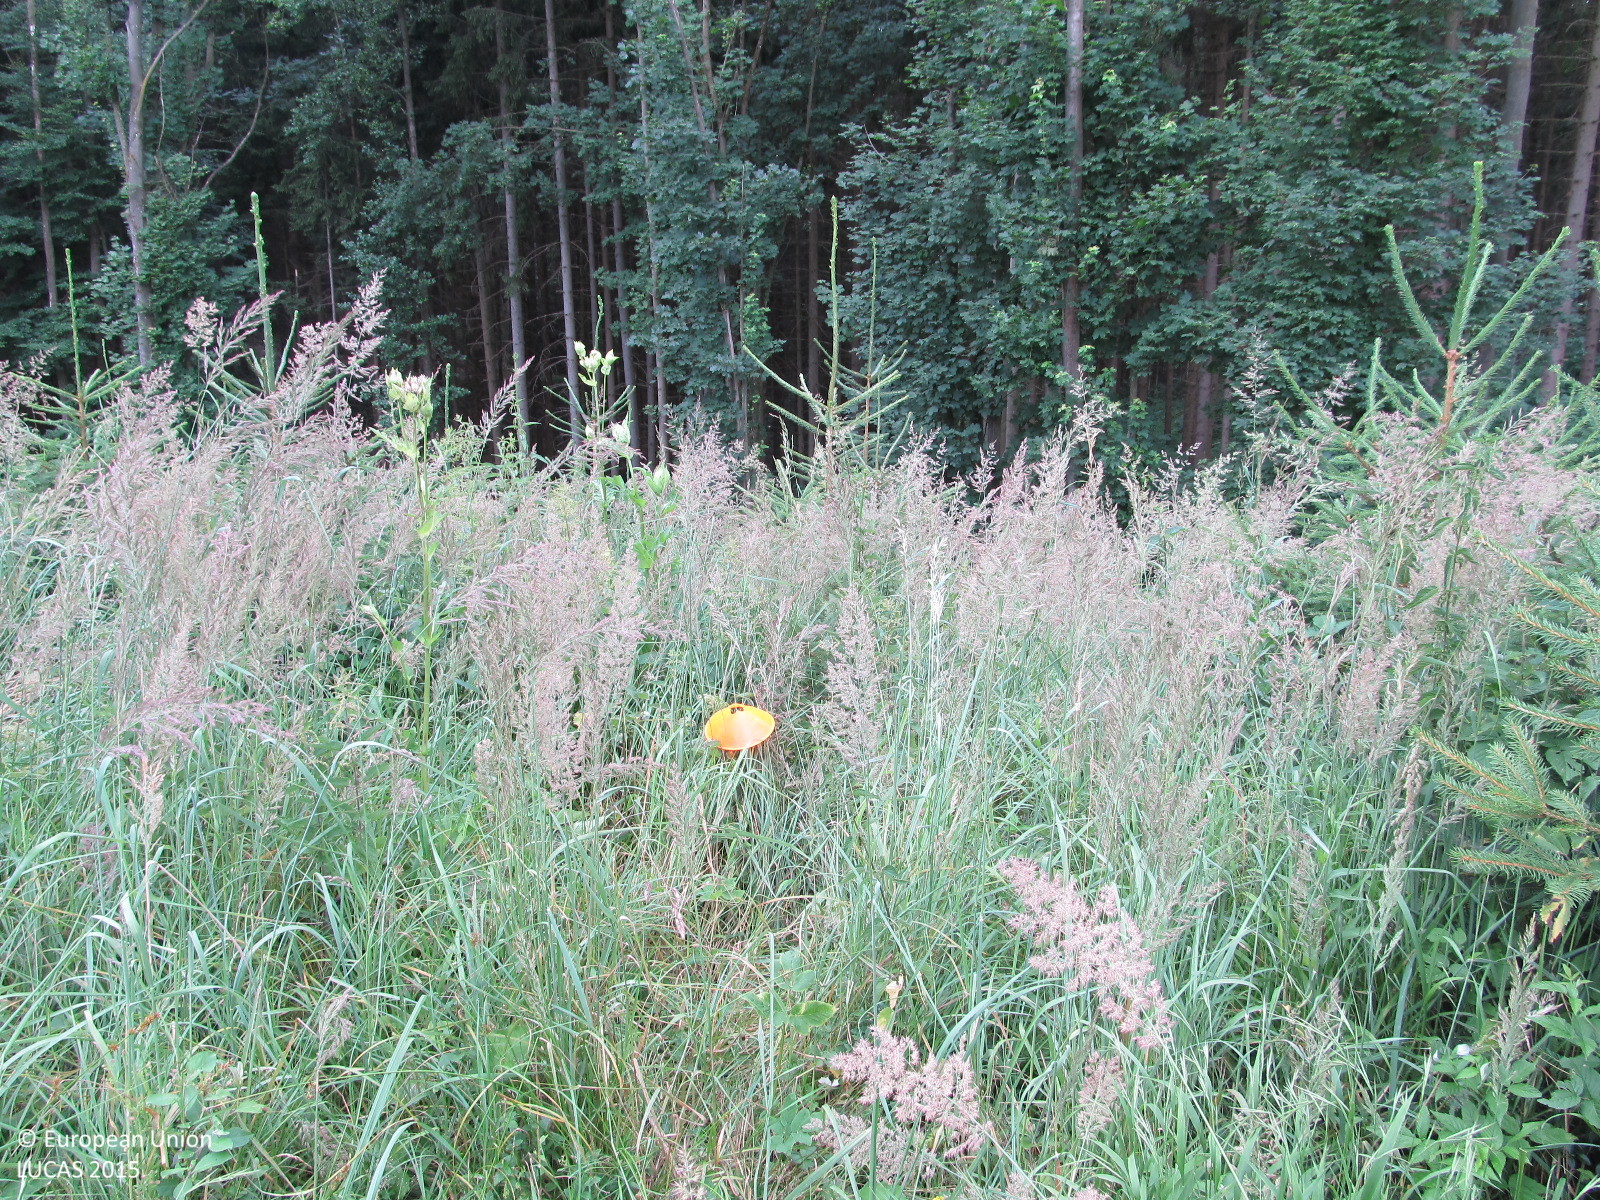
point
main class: Woodland
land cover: Spruce dominated coniferous woodland
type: hemiboreal forest and nemoral coniferous forest and mixed broadleaved-coniferous forest
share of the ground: > 75 %
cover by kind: coniferous forest trees 50 %, herbaceous plants 40 %, shrubs 10 %
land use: Forestry
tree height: < 5 m
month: July
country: AT
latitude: 48.4700
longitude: 15.3992
